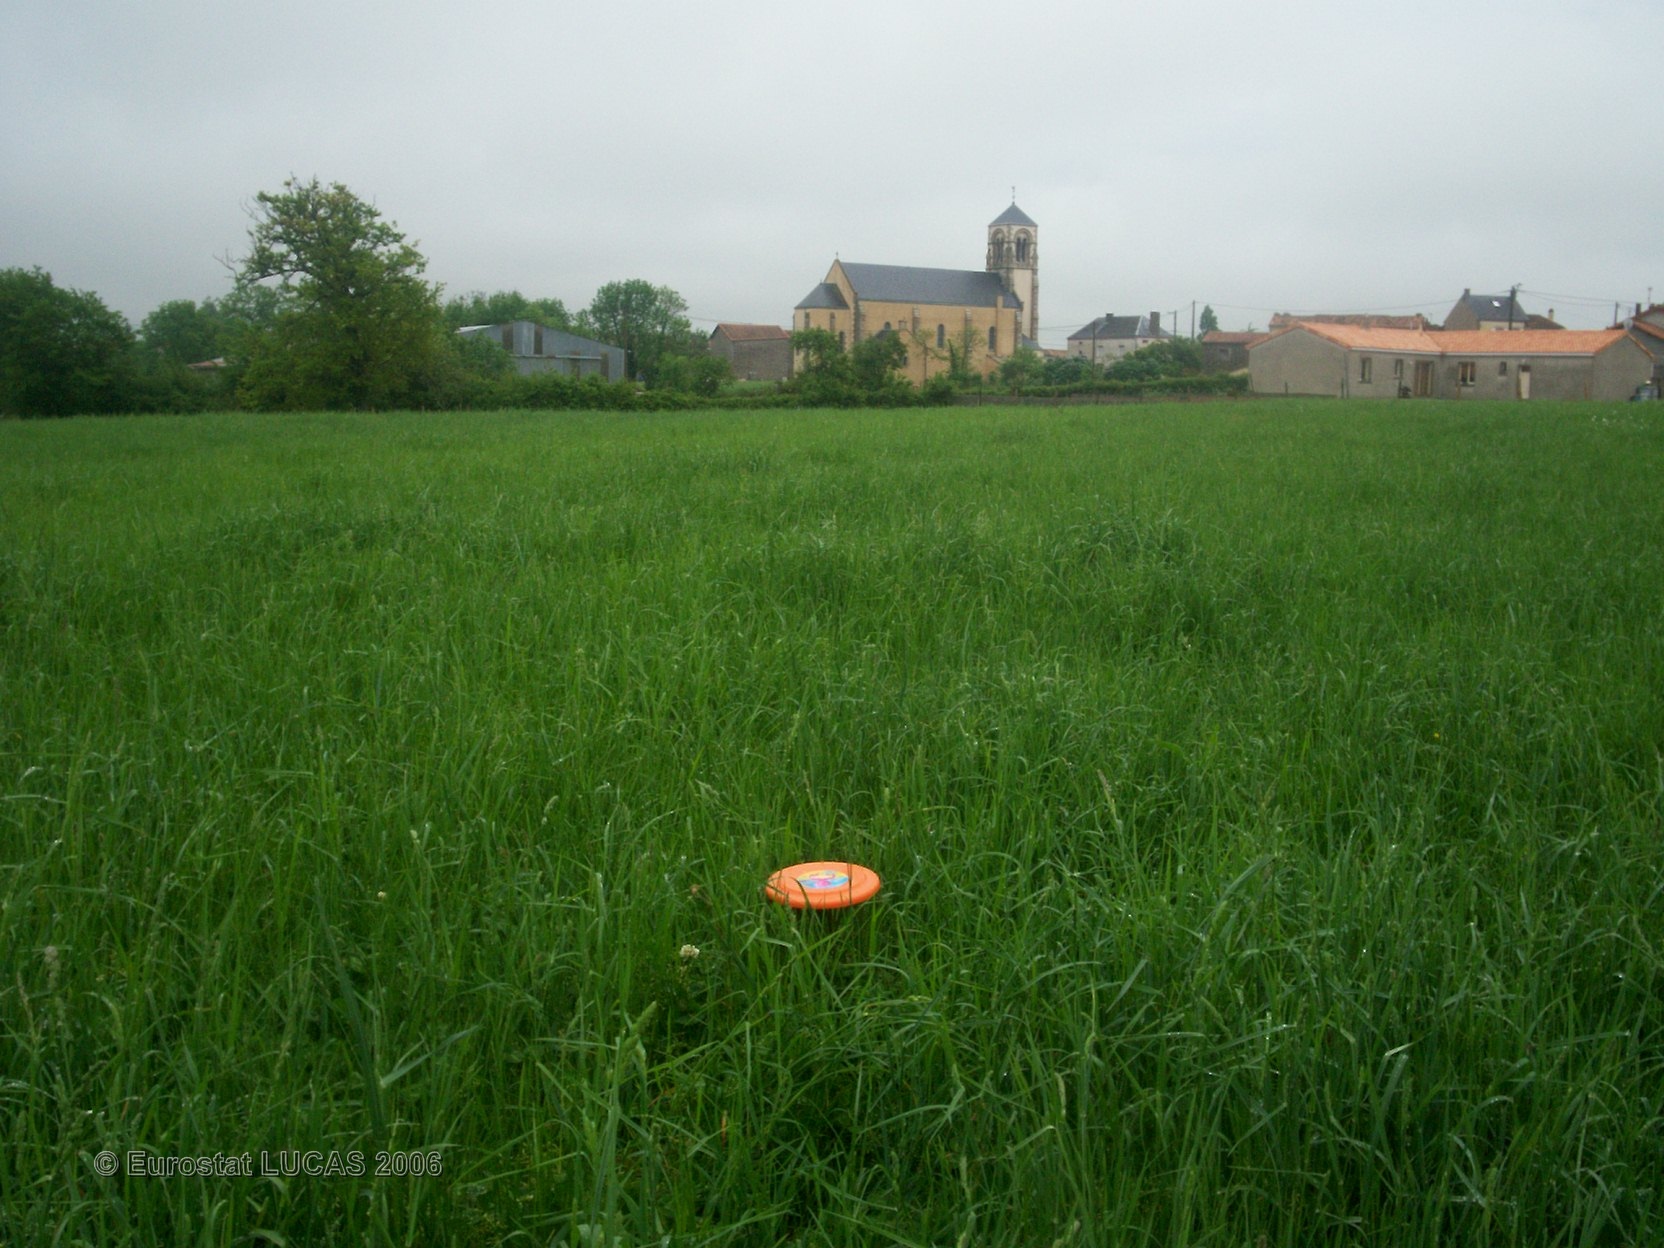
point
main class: Grassland
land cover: Grassland without tree/shrub cover
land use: Agriculture (excluding fallow land and kitchen gardens)
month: April
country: FR
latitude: 46.7191
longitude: -0.3484
